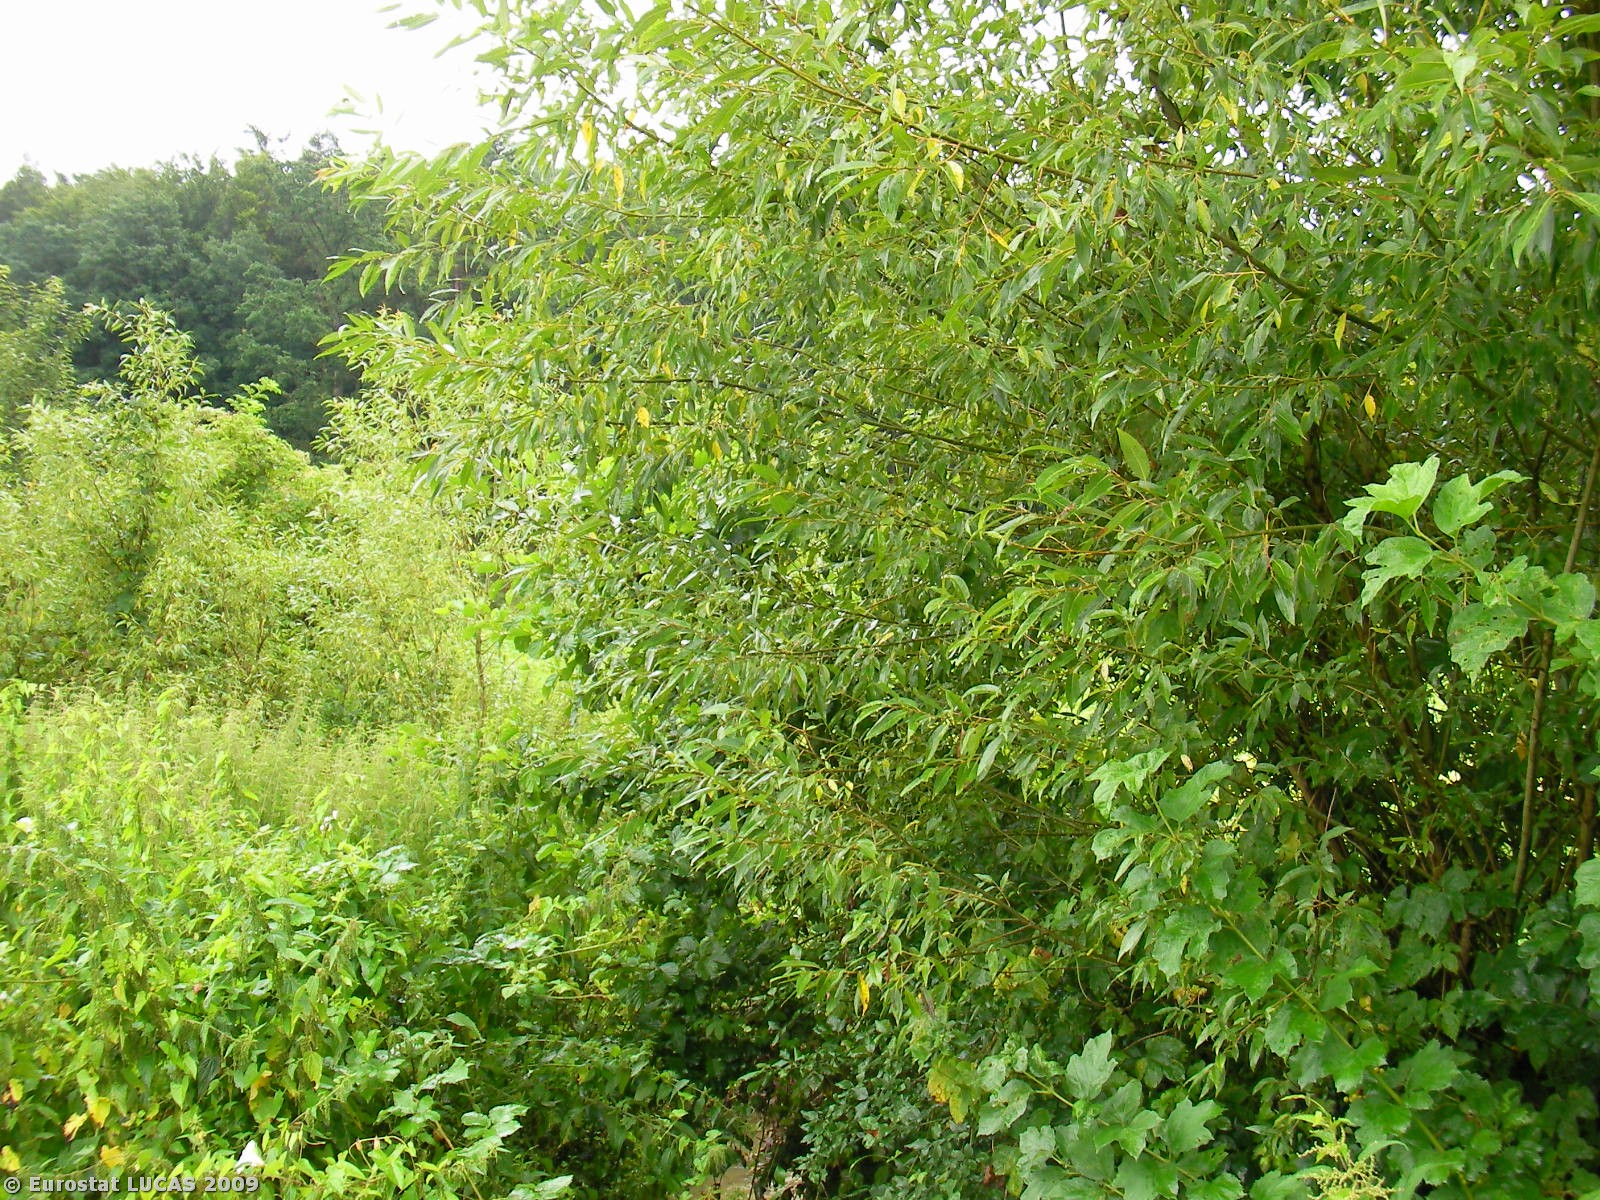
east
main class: Cropland
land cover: Other fibre and oleaginous crops
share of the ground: > 75 %
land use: Agriculture (excluding fallow land and kitchen gardens)
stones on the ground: < 10 %
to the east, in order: Other fibre and oleaginous crops; Abandoned hedges; Rivers and streams; Abandoned hedges; Grassland without tree/shrub cover; Other fibre and oleaginous crops; Groves; Broadleaved woodland
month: July
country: AT
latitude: 46.9386
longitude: 15.7144
